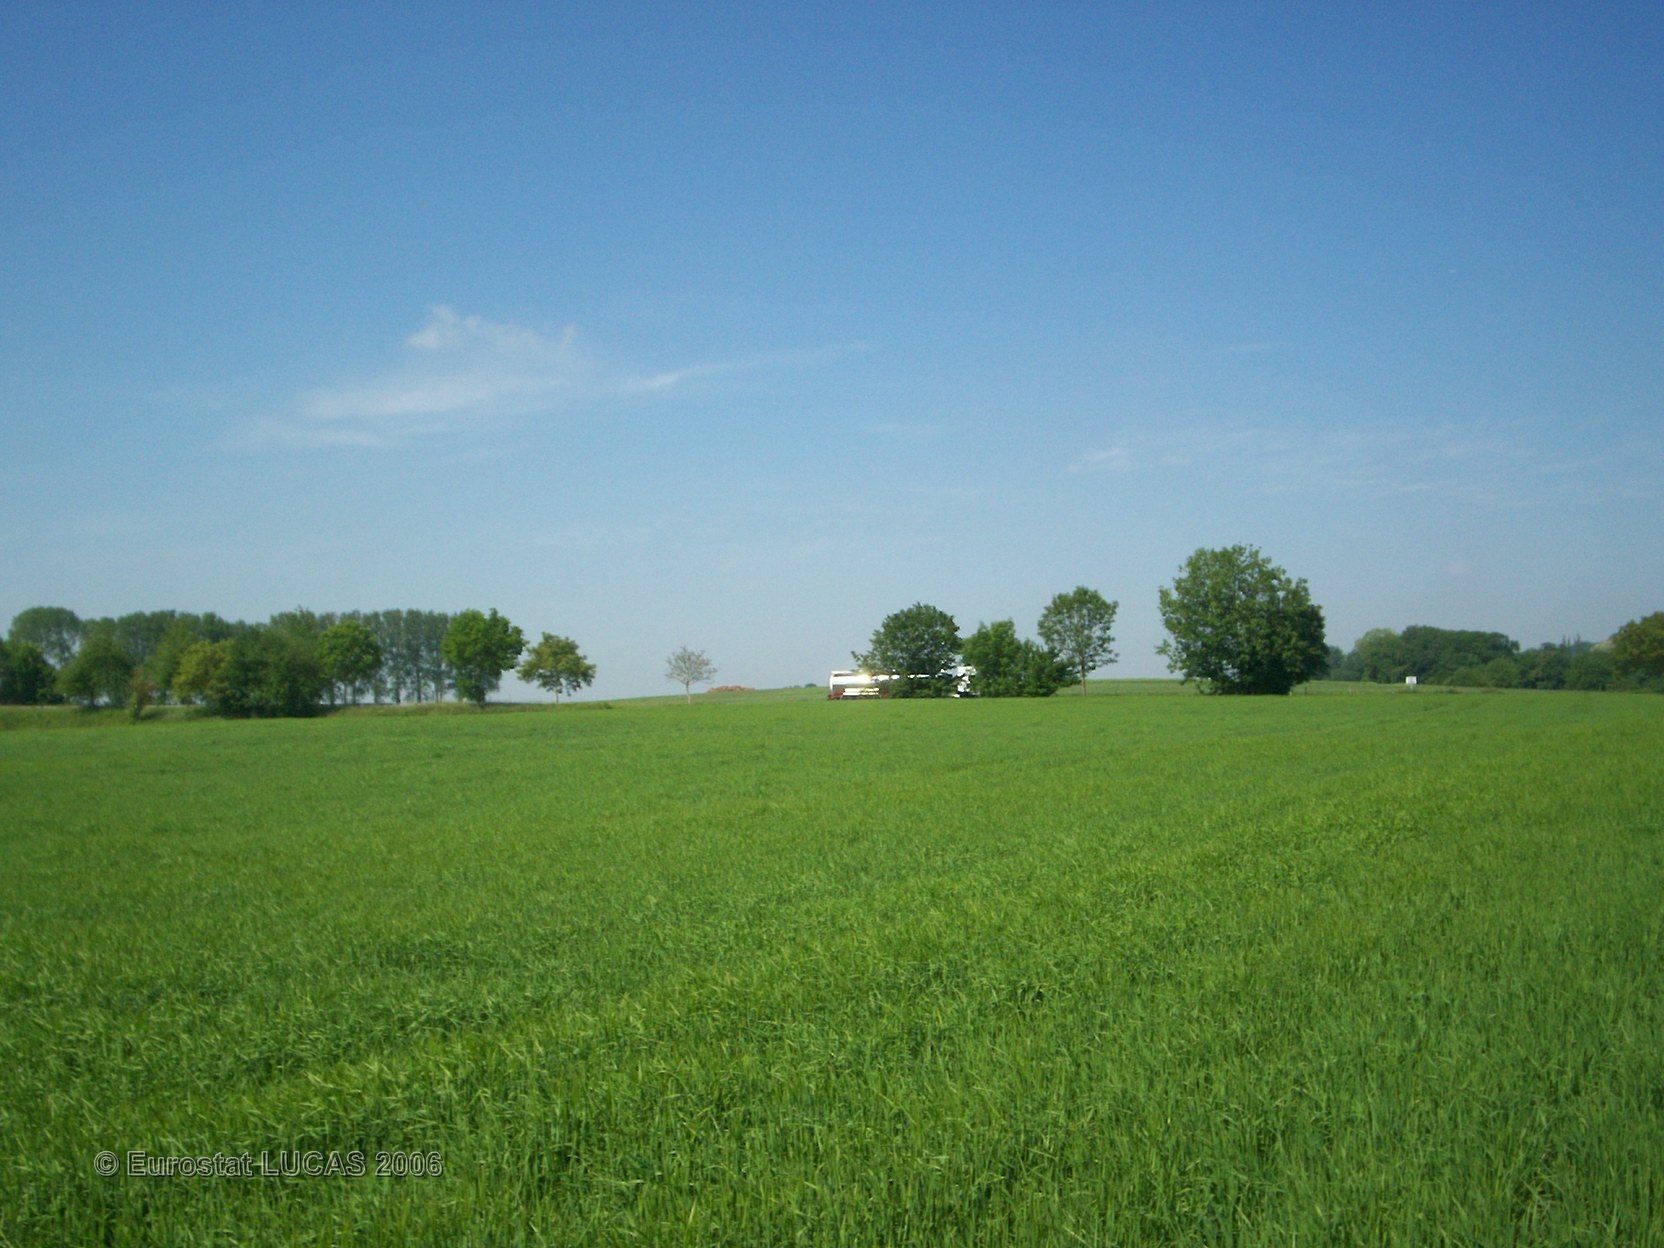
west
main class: Cropland
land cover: Oats
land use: Agriculture (excluding fallow land and kitchen gardens)
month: June
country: FR
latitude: 49.6086
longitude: 2.7238
